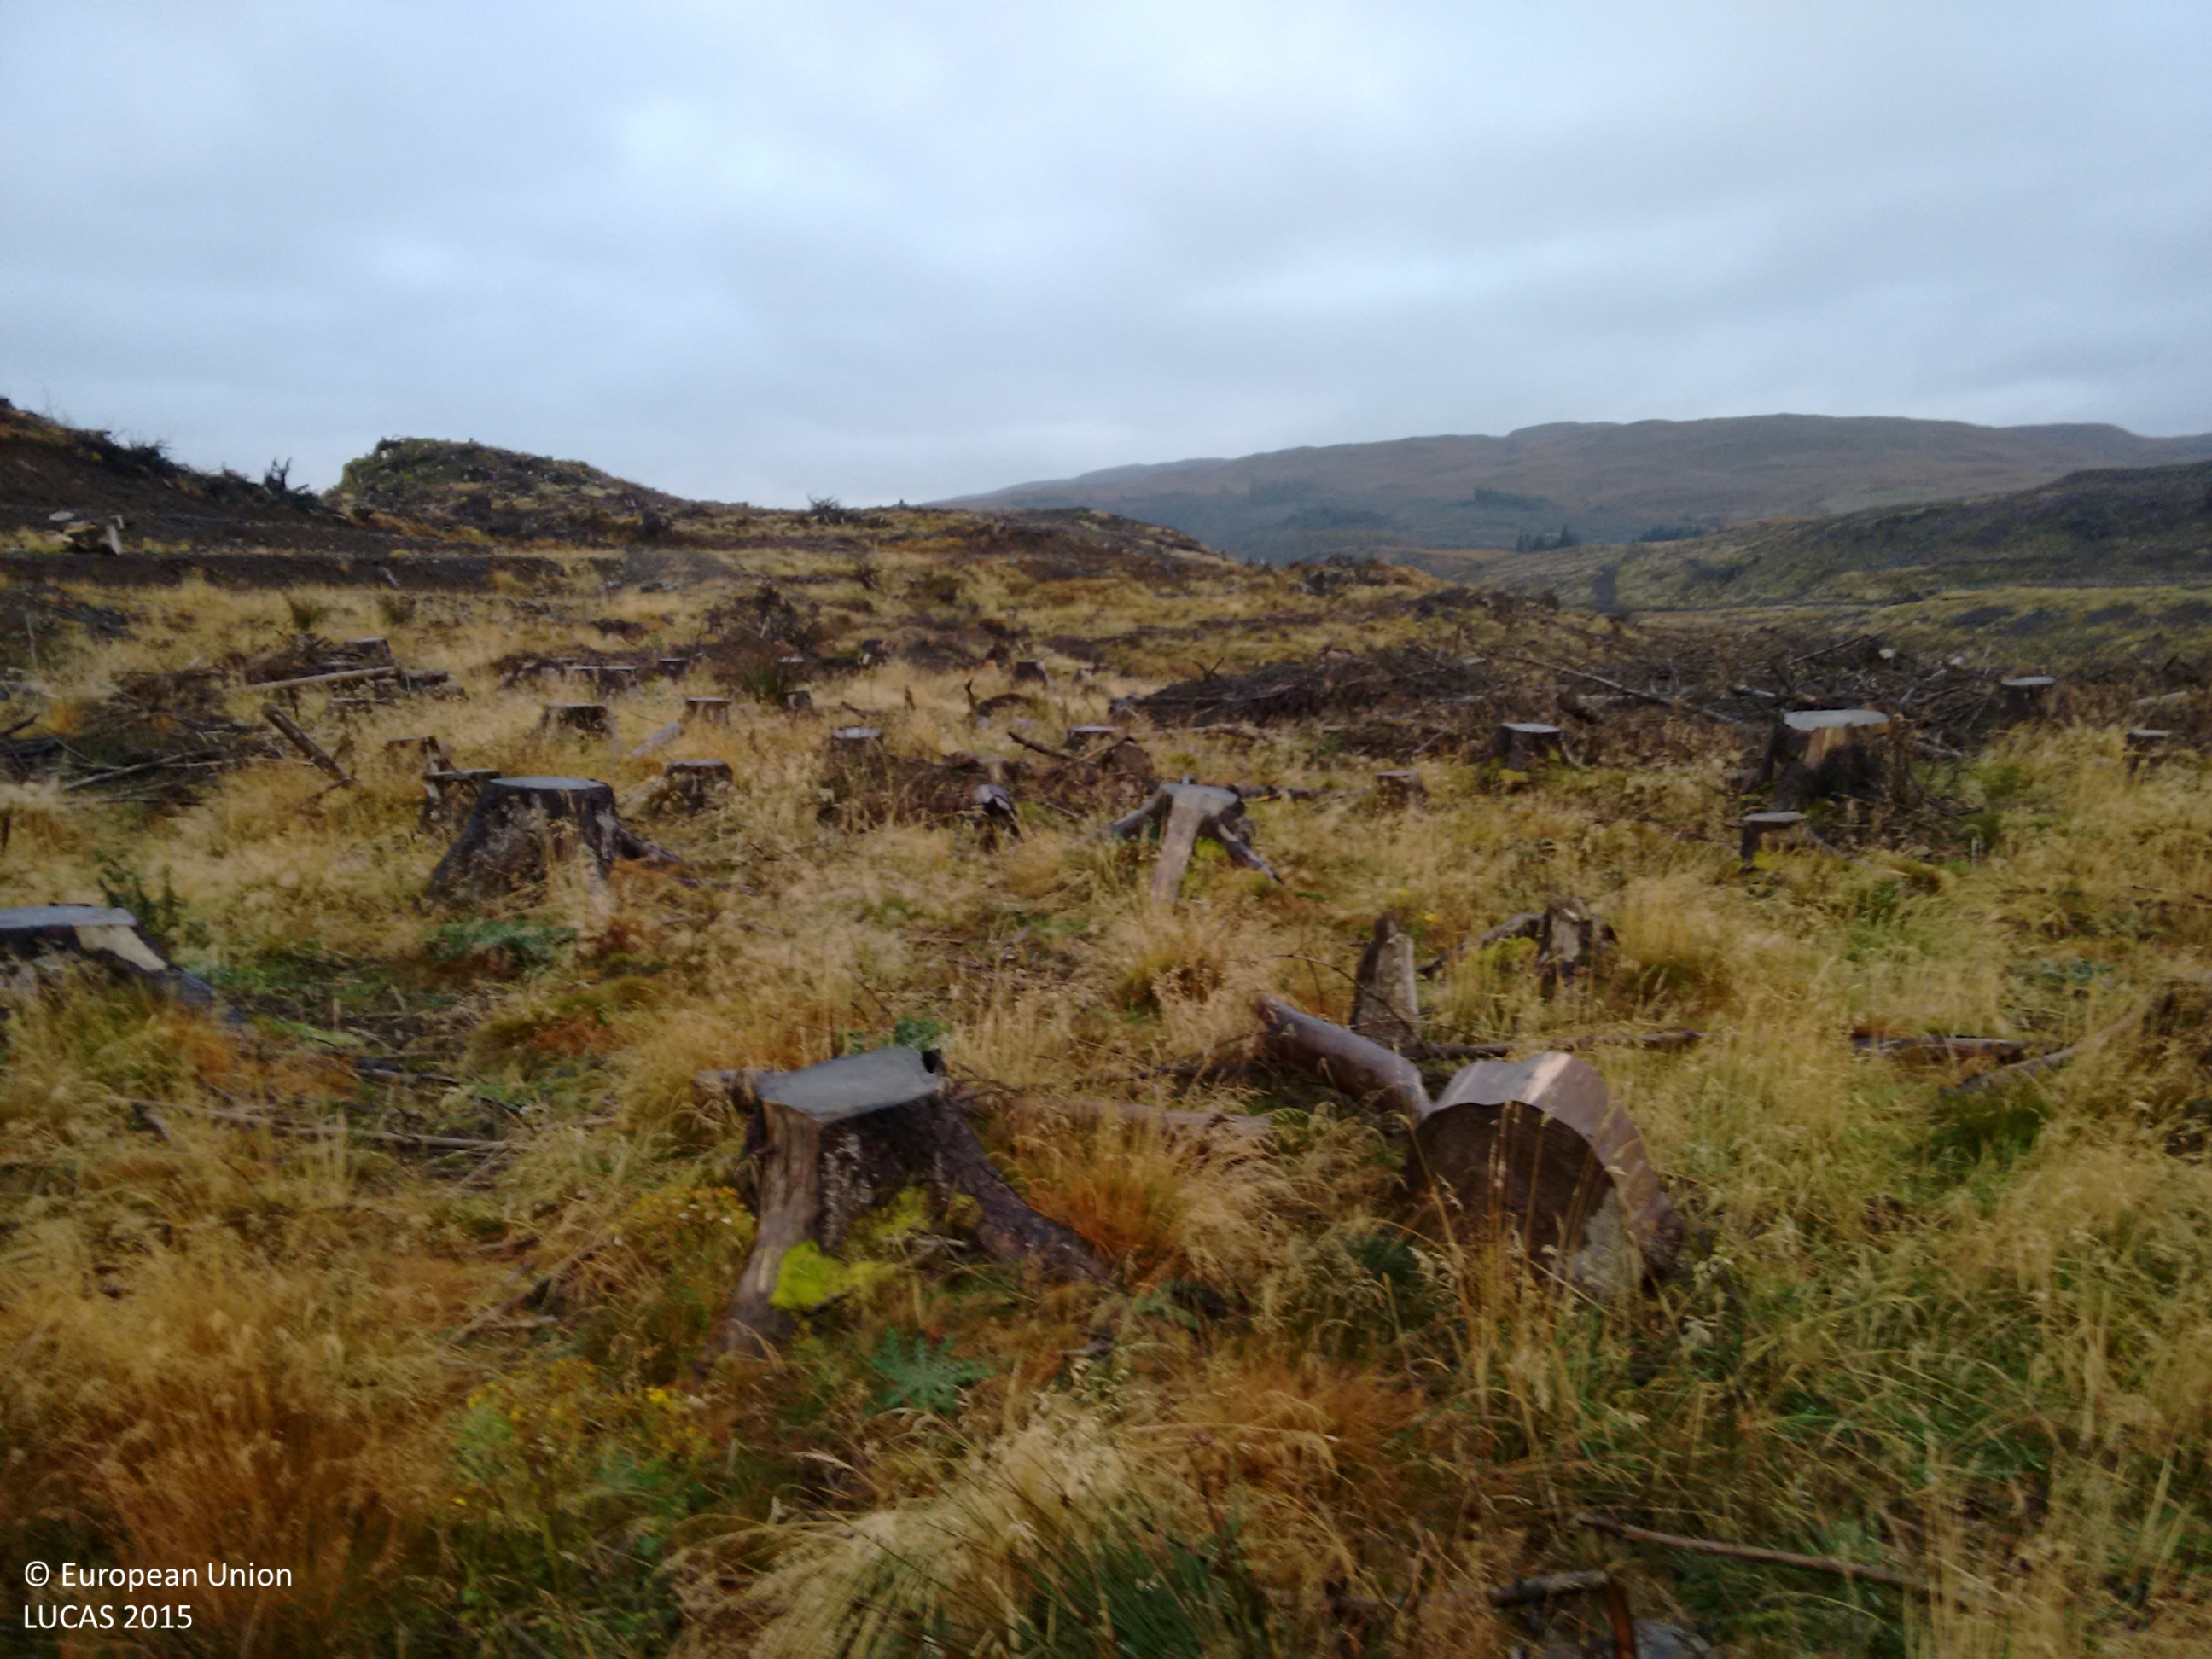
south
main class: Grassland
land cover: Grassland without tree/shrub cover
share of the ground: > 75 %
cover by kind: herbaceous plants 75 %, lichens and mosses 5 %
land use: Forestry
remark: Clear cut
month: October
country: GB
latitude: 56.5948
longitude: -6.2469
